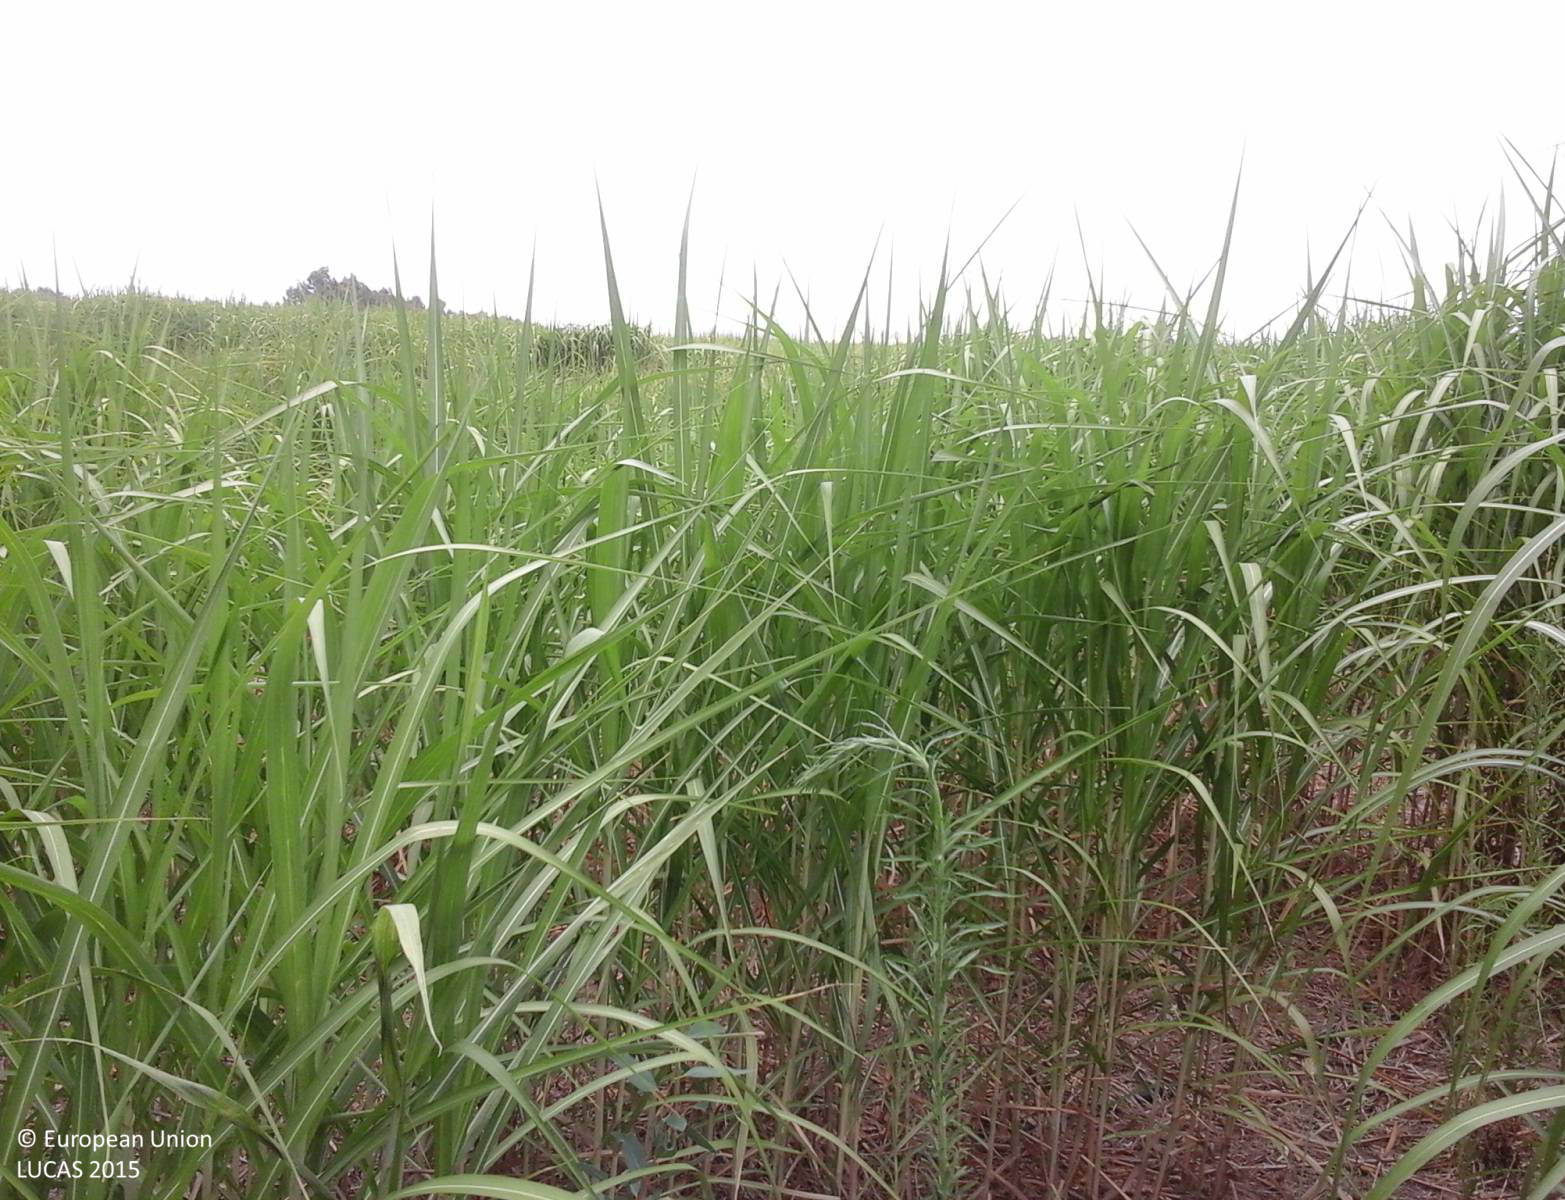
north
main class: Cropland
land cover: Permanent industrial crops
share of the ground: > 75 %
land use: Agriculture (excluding fallow land and kitchen gardens)
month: July
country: IT
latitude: 39.4638
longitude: 8.8562
